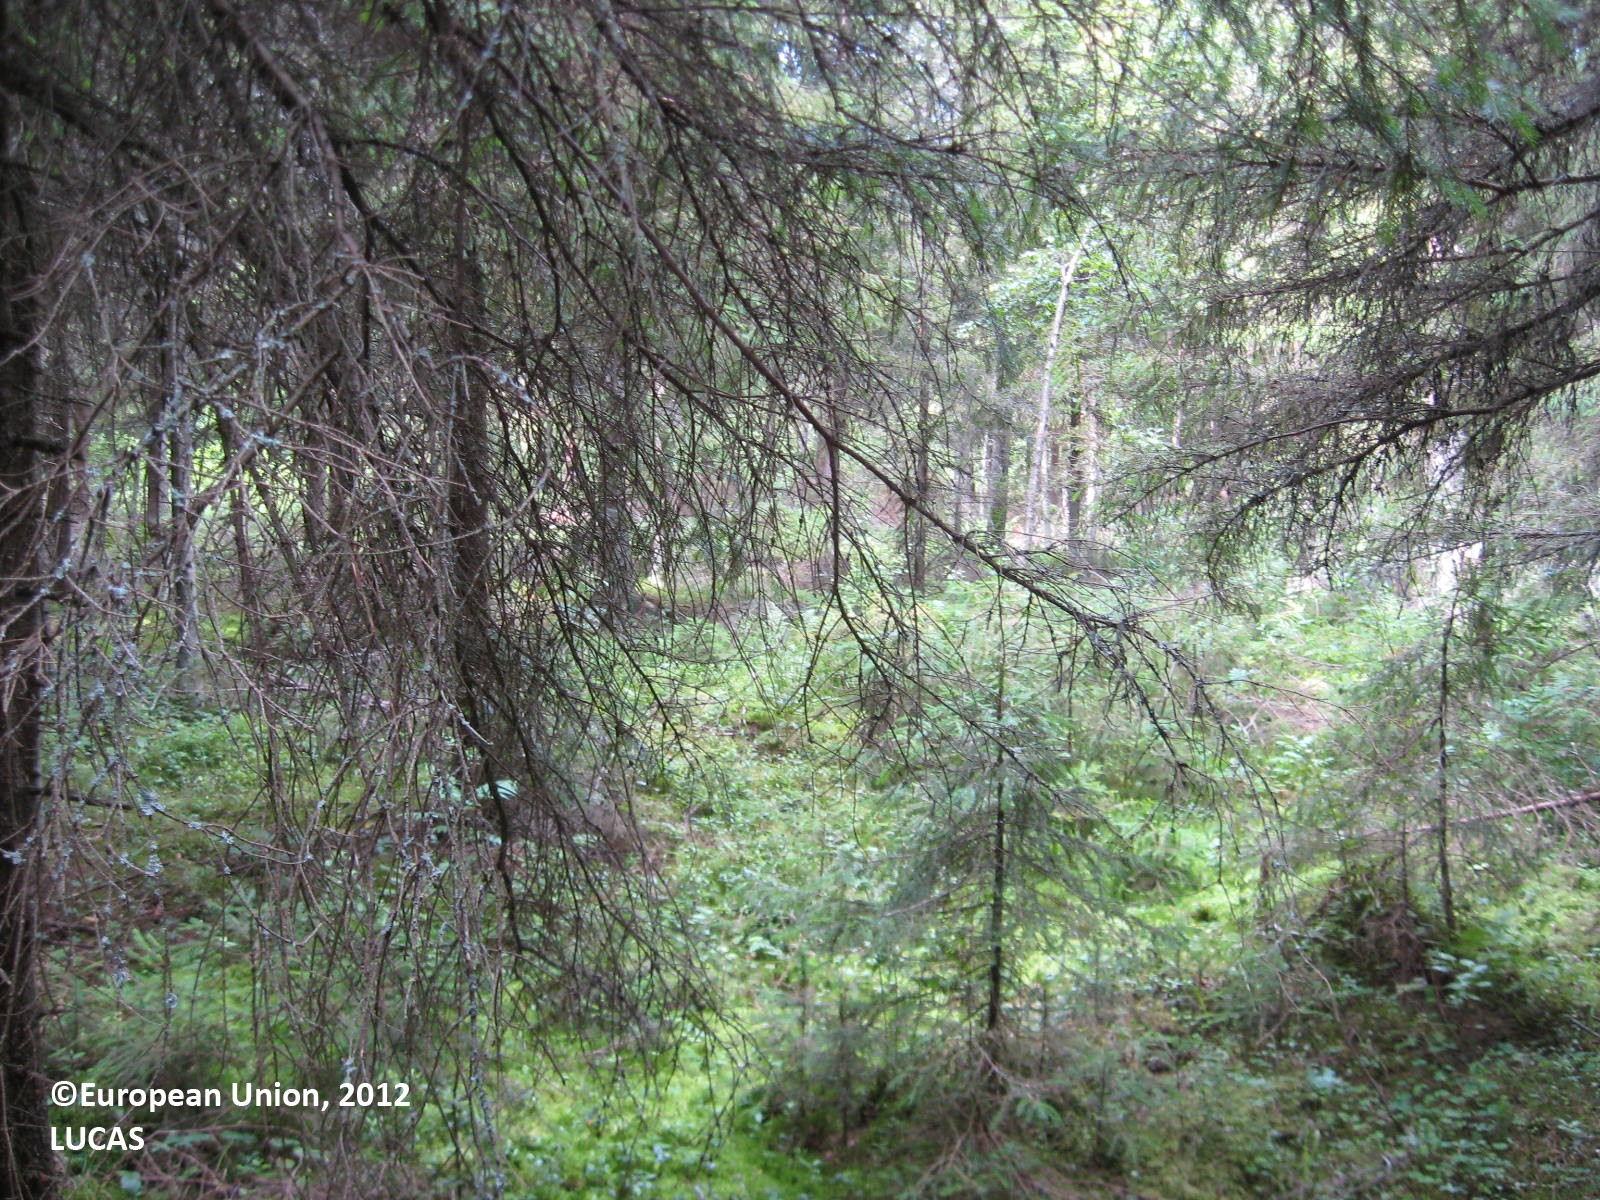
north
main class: Woodland
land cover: Spruce dominated coniferous woodland
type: boreal forest
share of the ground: > 75 %
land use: Forestry
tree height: > 5 m
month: July
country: FI
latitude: 62.4297
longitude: 21.4505
